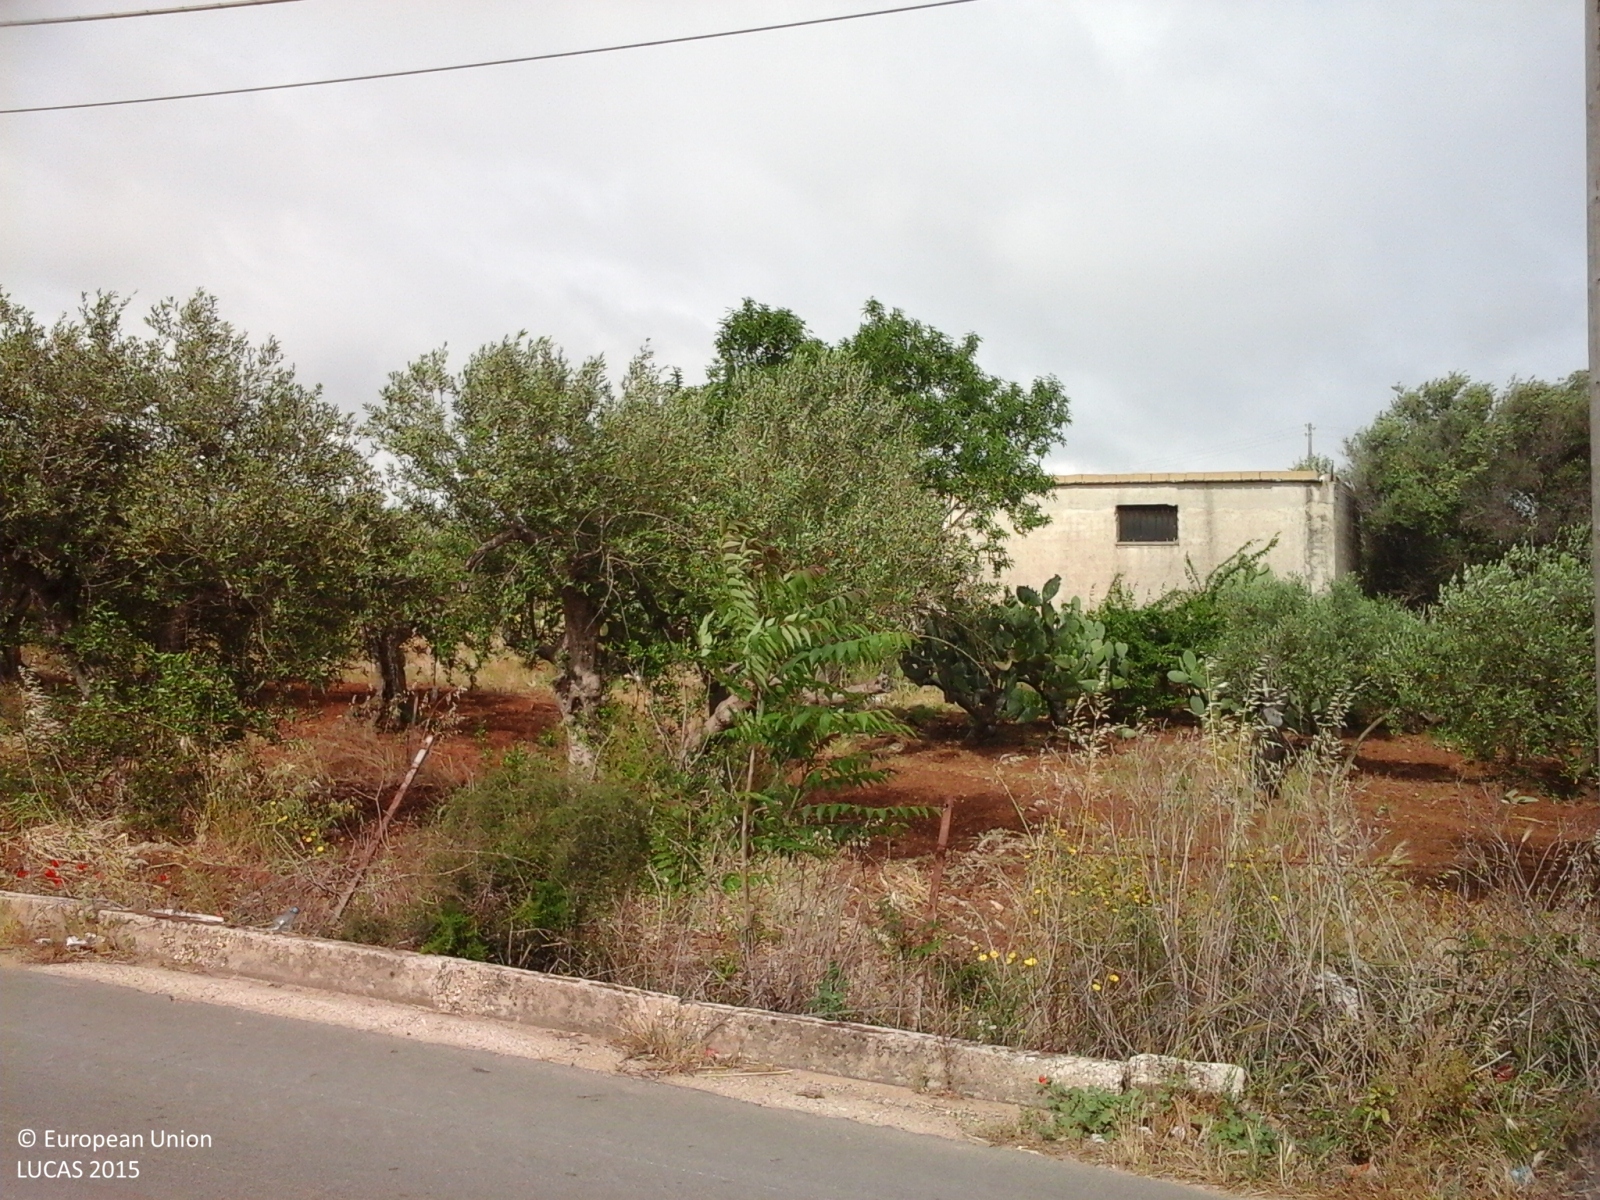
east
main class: Cropland
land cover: Olive groves
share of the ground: 50 - 75 %
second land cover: Other bare soil
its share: > 75 %
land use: Agriculture (excluding fallow land and kitchen gardens)
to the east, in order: Olive groves; Other bare soil; Oranges; Other fruit trees and berries; Fences; Paved roads, cycling and walking lanes; Fences; Olive groves; Artificial constructions in urban areas; Olive groves; Permanent crops (only in case pi); Arable land (only in case pi); Shrubland without tree cover; Tracks; Shrubland with sparse tree cover
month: May
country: IT
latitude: 37.6819
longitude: 13.0049
